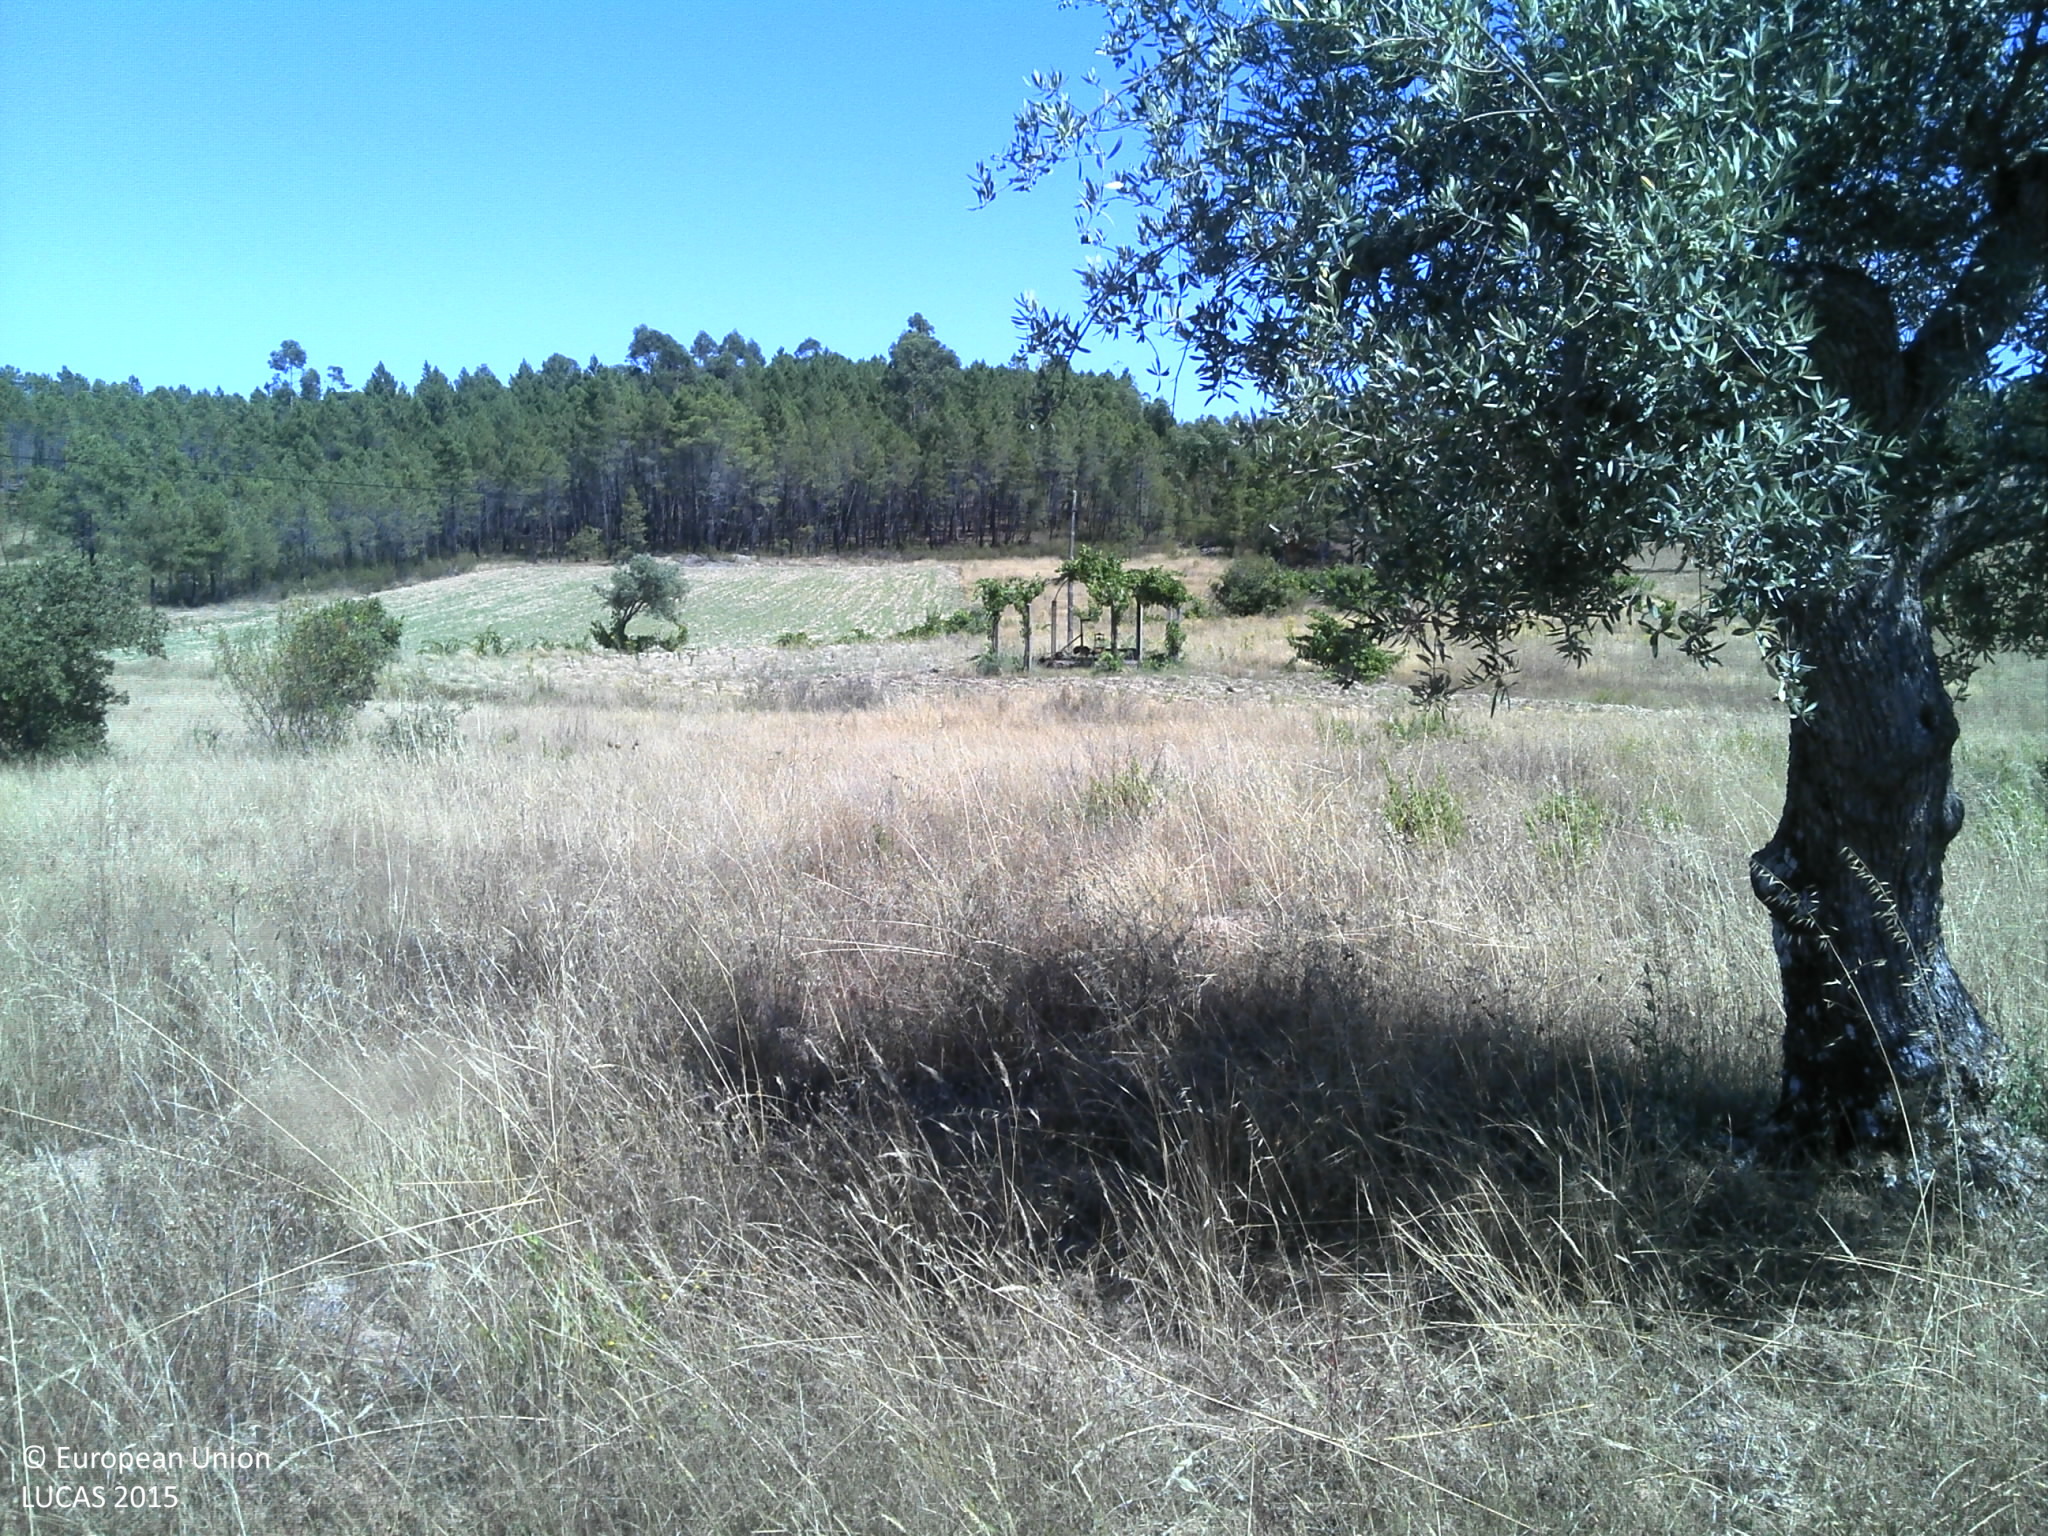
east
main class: Cropland
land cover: Olive groves
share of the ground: 25 - 50 %
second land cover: Grassland without tree/shrub cover
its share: 25 - 50 %
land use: Agriculture (excluding fallow land and kitchen gardens)
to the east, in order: Olive groves; Grassland without tree/shrub cover; Grassland with sparse tree/shrub cover; Grassland without tree/shrub cover; Tracks; Spontaneously vegetated surfaces; Maize; Pine dominated coniferous woodland
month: July
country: PT
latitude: 39.8577
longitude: -7.6248
